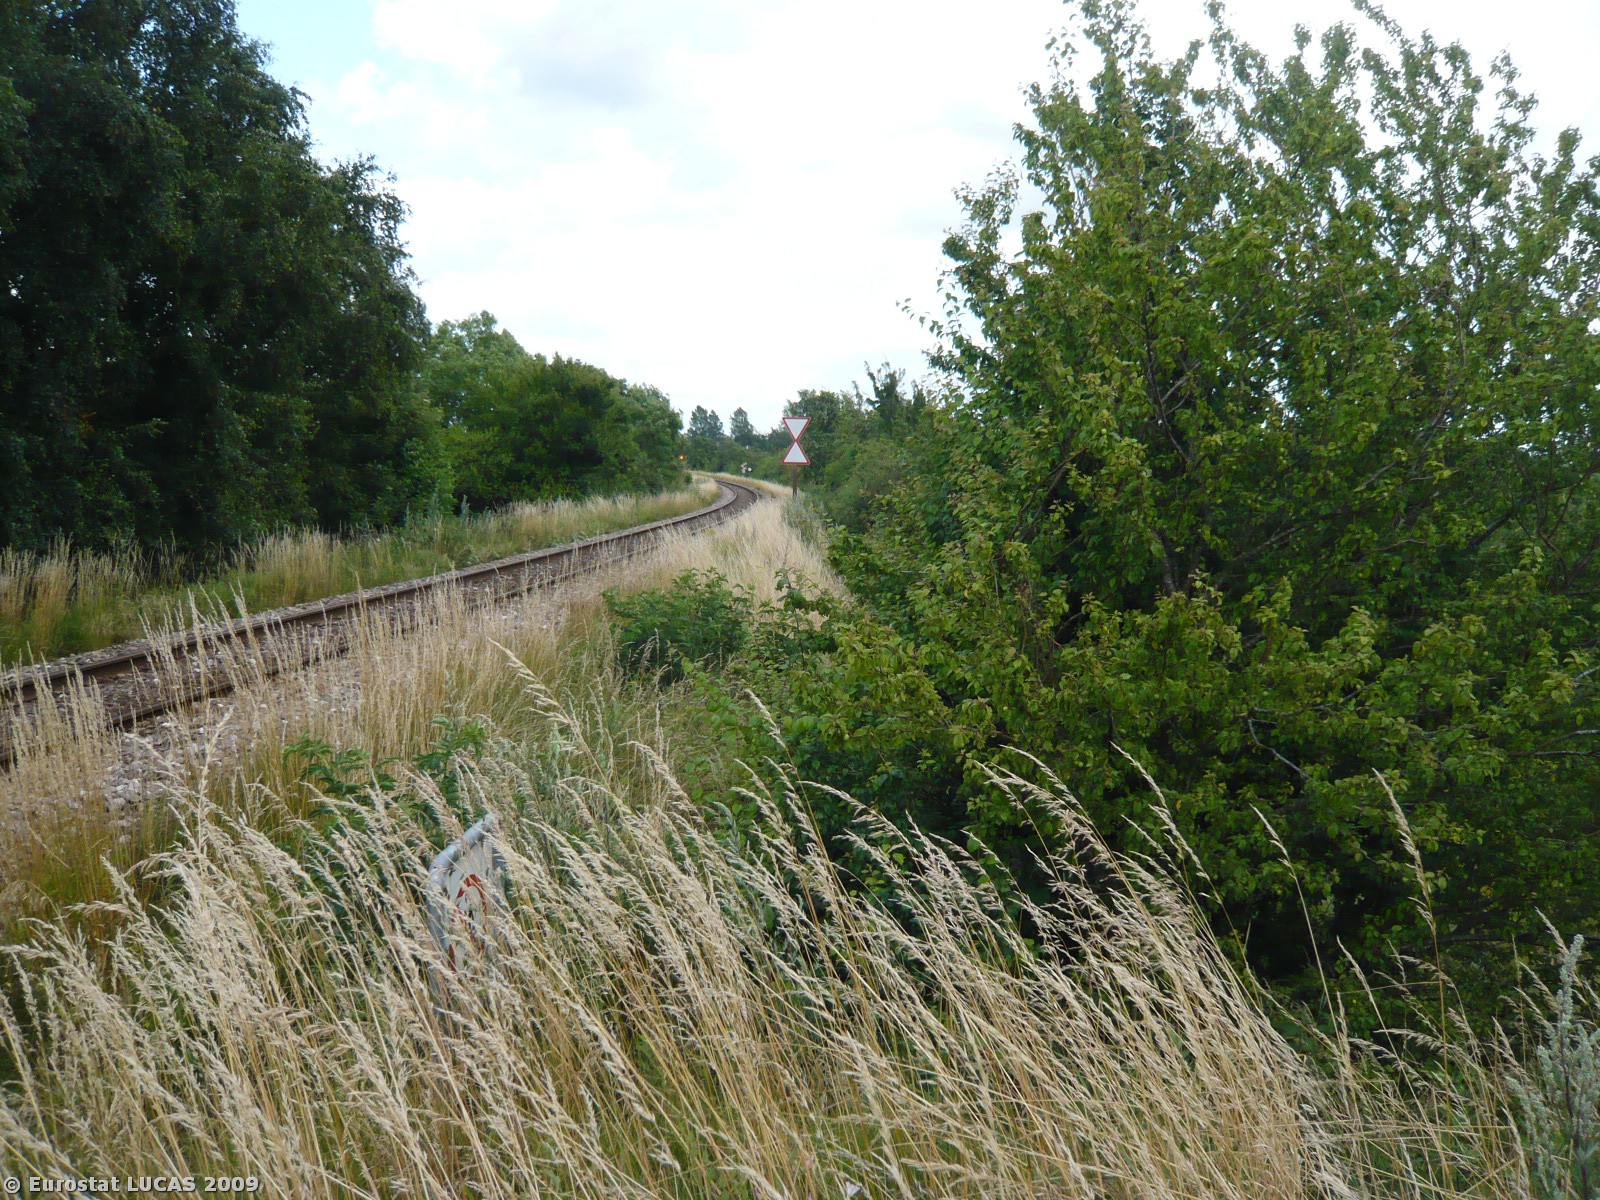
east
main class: Woodland
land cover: Broadleaved woodland
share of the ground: > 75 %
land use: Railway transport
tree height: > 5 m
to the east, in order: Broadleaved woodland; Grassland without tree/shrub cover; Fences; Grassland without tree/shrub cover; Ditches and canals; Grassland without tree/shrub cover
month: July
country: DK
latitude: 55.5314
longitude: 11.5354
